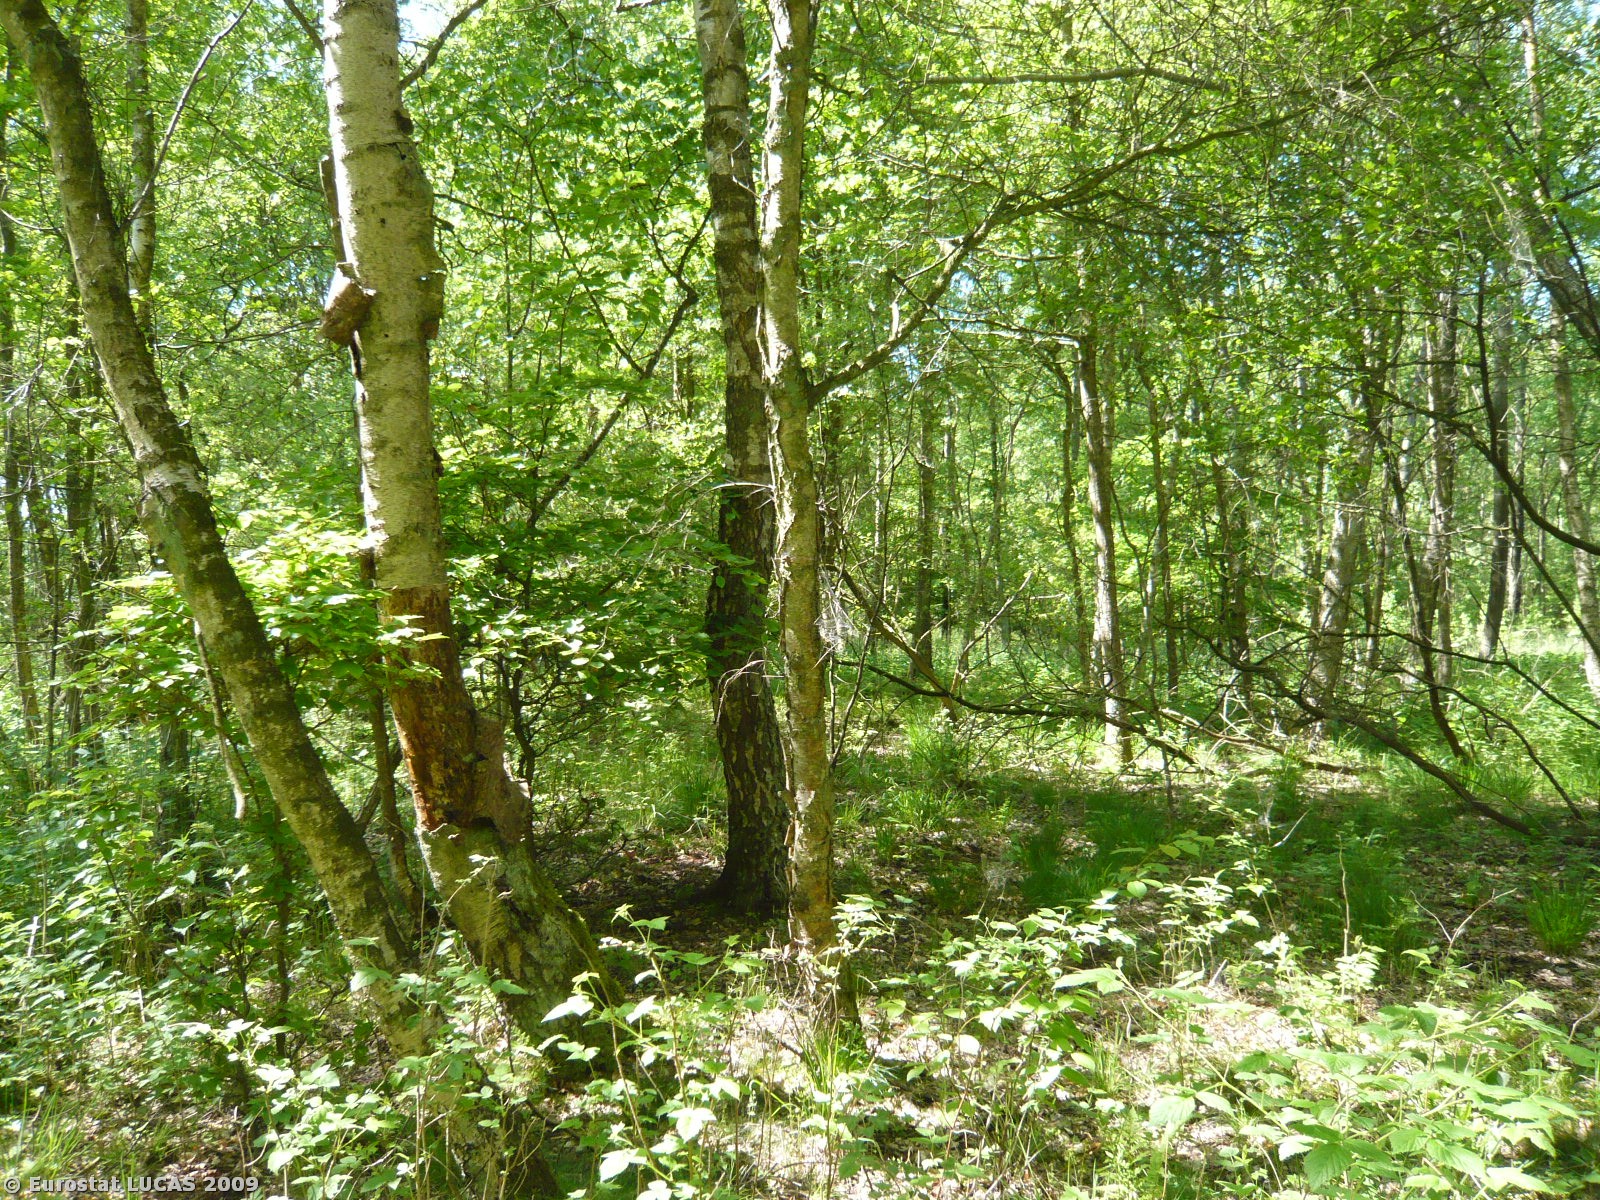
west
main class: Woodland
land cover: Broadleaved woodland
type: non-riverine alder, birch or aspen forest
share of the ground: > 75 %
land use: Forestry
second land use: Amenities, museums, leisure
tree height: > 5 m
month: May
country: DK
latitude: 55.3124
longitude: 11.7790
